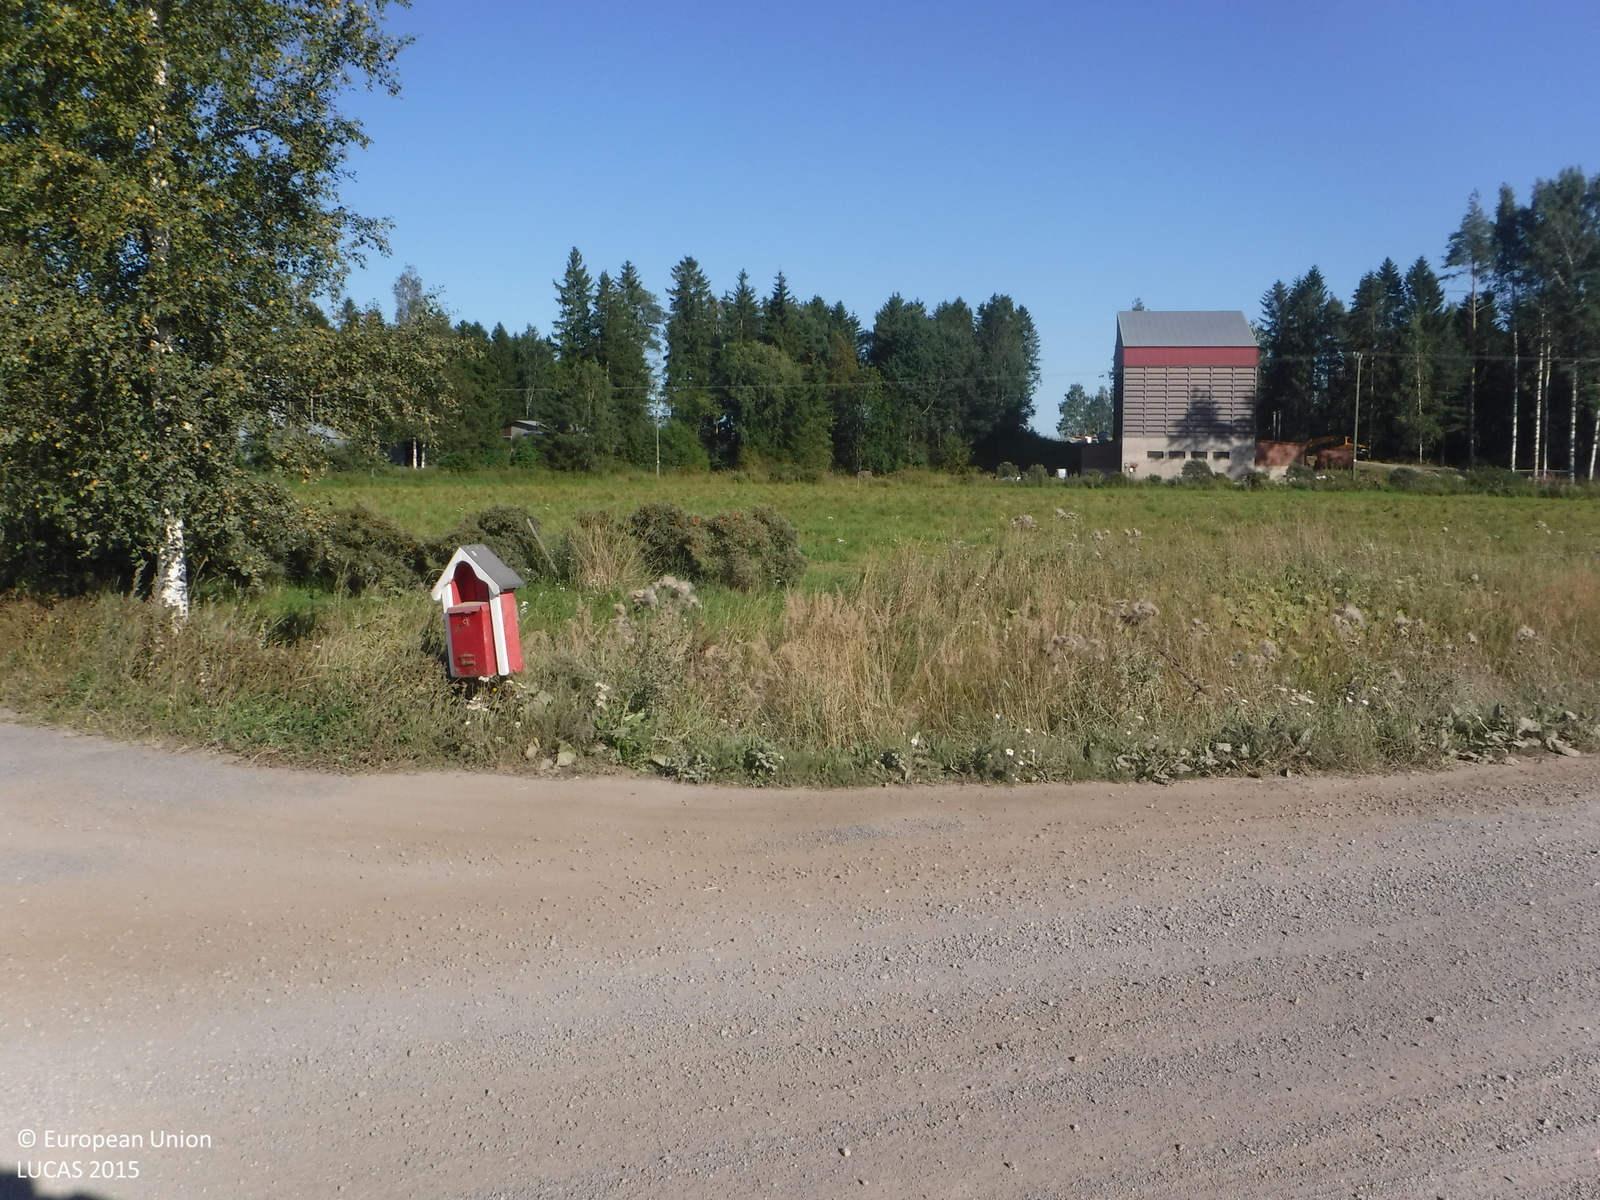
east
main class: Cropland
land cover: Barley
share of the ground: > 75 %
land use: Agriculture (excluding fallow land and kitchen gardens)
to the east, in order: Barley; Grass margins; Ditches and canals; Grass margins; Paved roads, cycling and walking lanes; Grass margins; Ditches and canals; Grass margins; Fences; Grassland without tree/shrub cover; Artificial constructions in urban areas
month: August
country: FI
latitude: 61.2001
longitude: 22.6278
